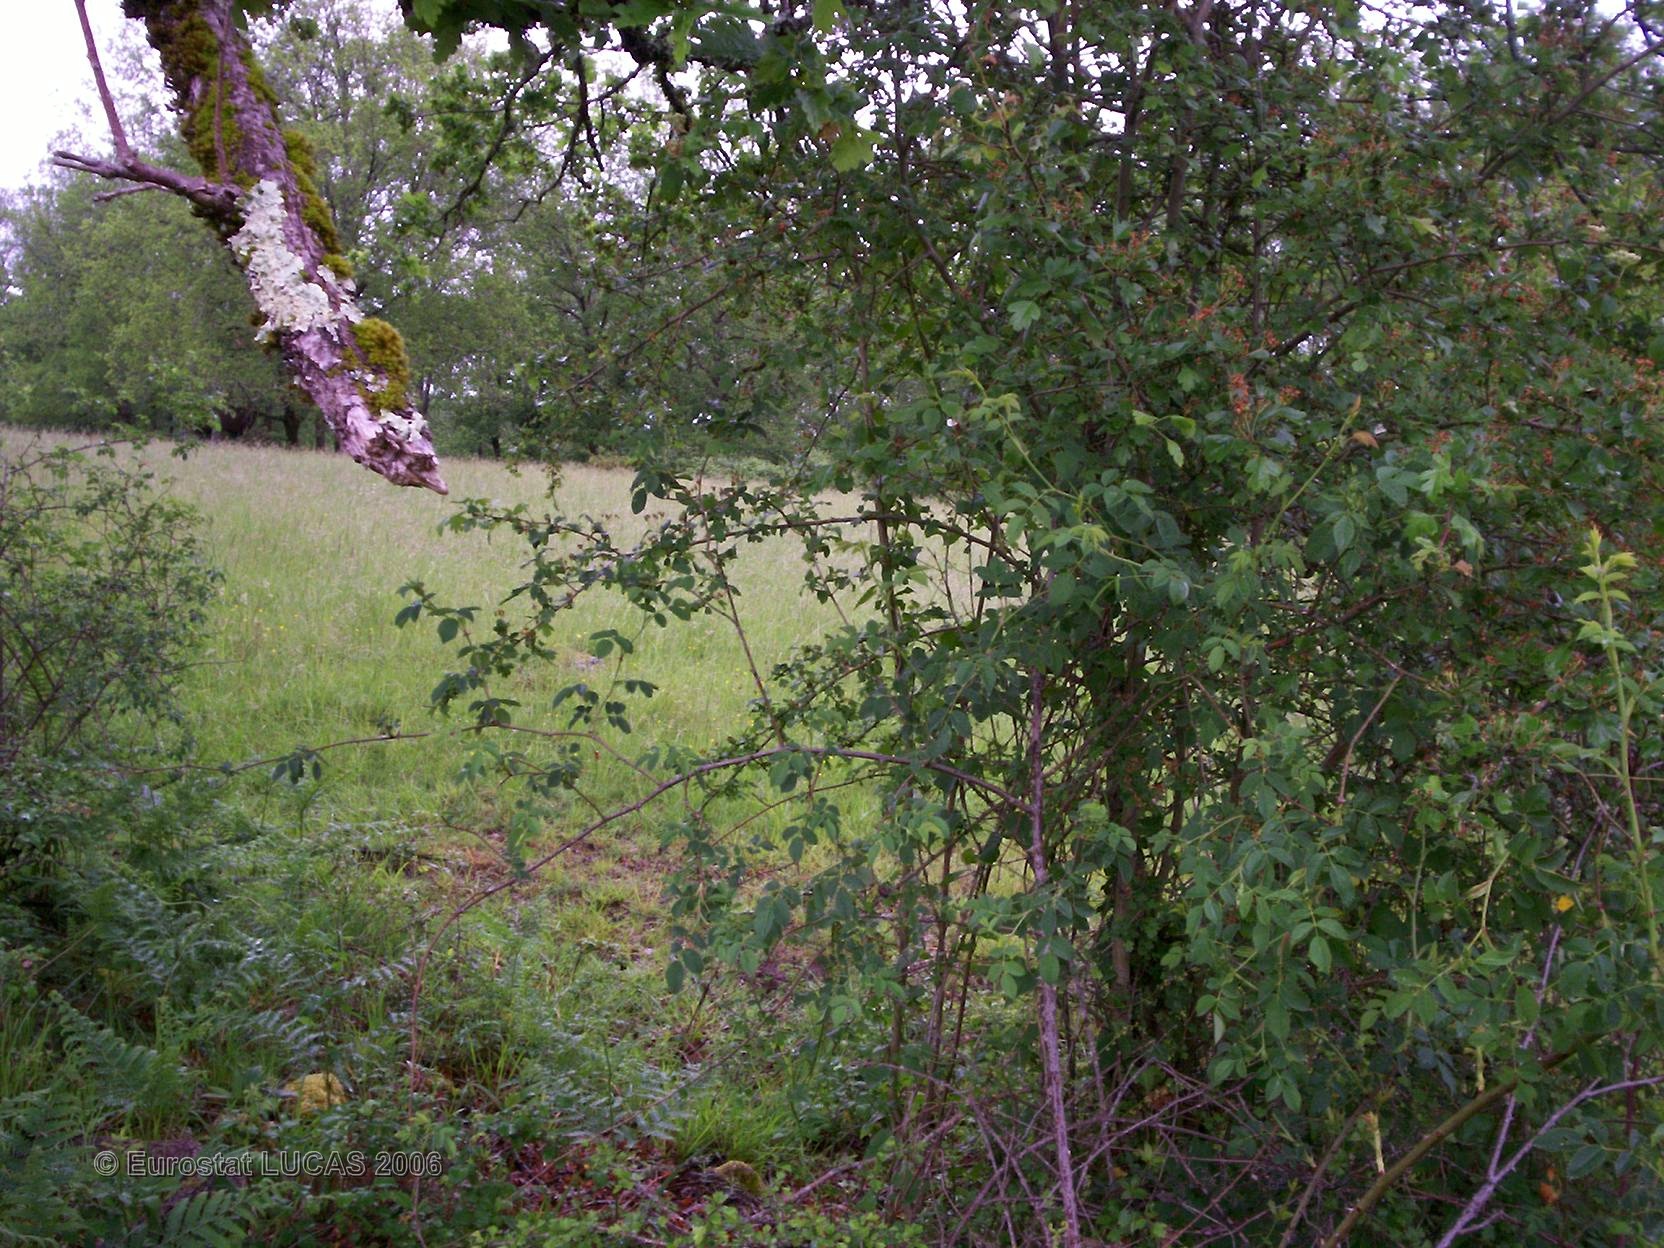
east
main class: Grassland
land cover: Grassland with sparse tree/shrub cover
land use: Agriculture (excluding fallow land and kitchen gardens)
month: May
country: FR
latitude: 45.4058
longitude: 0.5461
